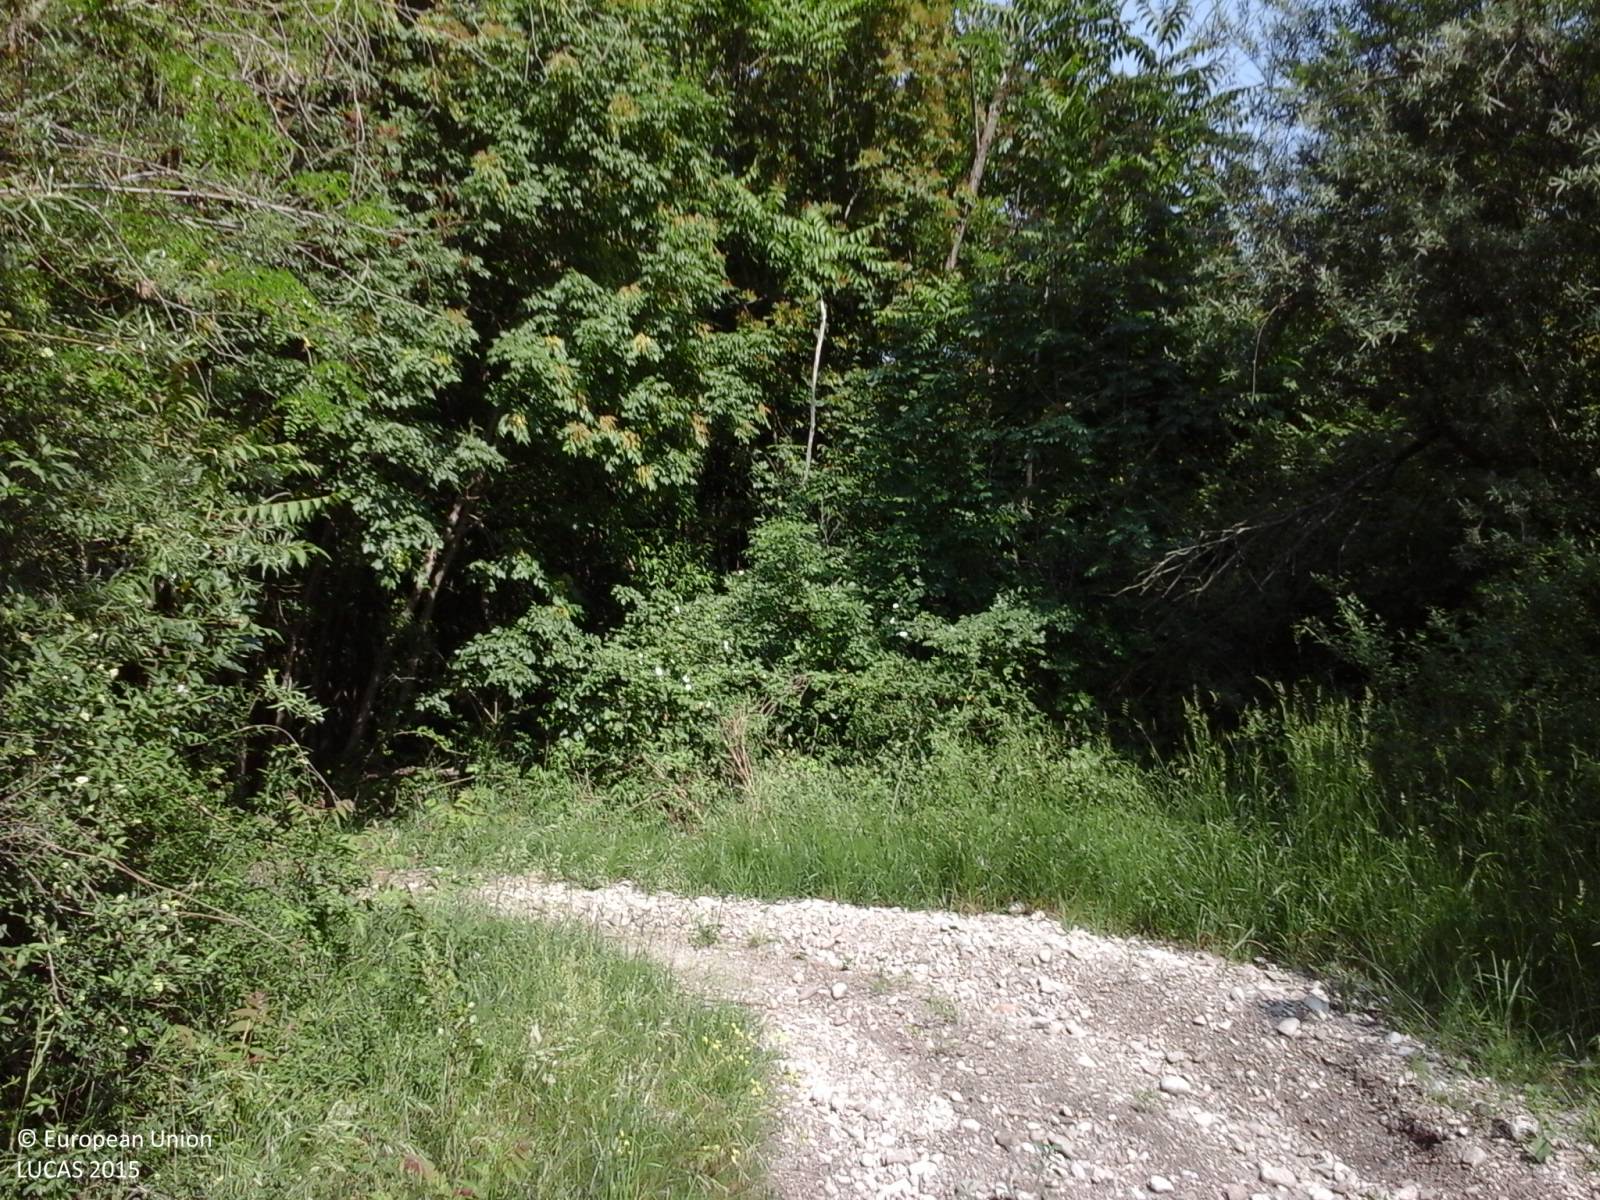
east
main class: Woodland
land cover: Broadleaved woodland
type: mesophytic deciduous forest
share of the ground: > 75 %
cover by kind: broadleaved forest trees 85 %, shrubs 10 %, herbaceous plants 5 %
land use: Forestry
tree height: > 5 m
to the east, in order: Broadleaved woodland; Tracks; Broadleaved woodland; Grassland without tree/shrub cover; Vineyards; Grassland without tree/shrub cover; Vineyards; Grass margins; Tracks; Grass margins; Vineyards; Grass margins; Dry pulses
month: May
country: IT
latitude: 46.0114
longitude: 13.3155
